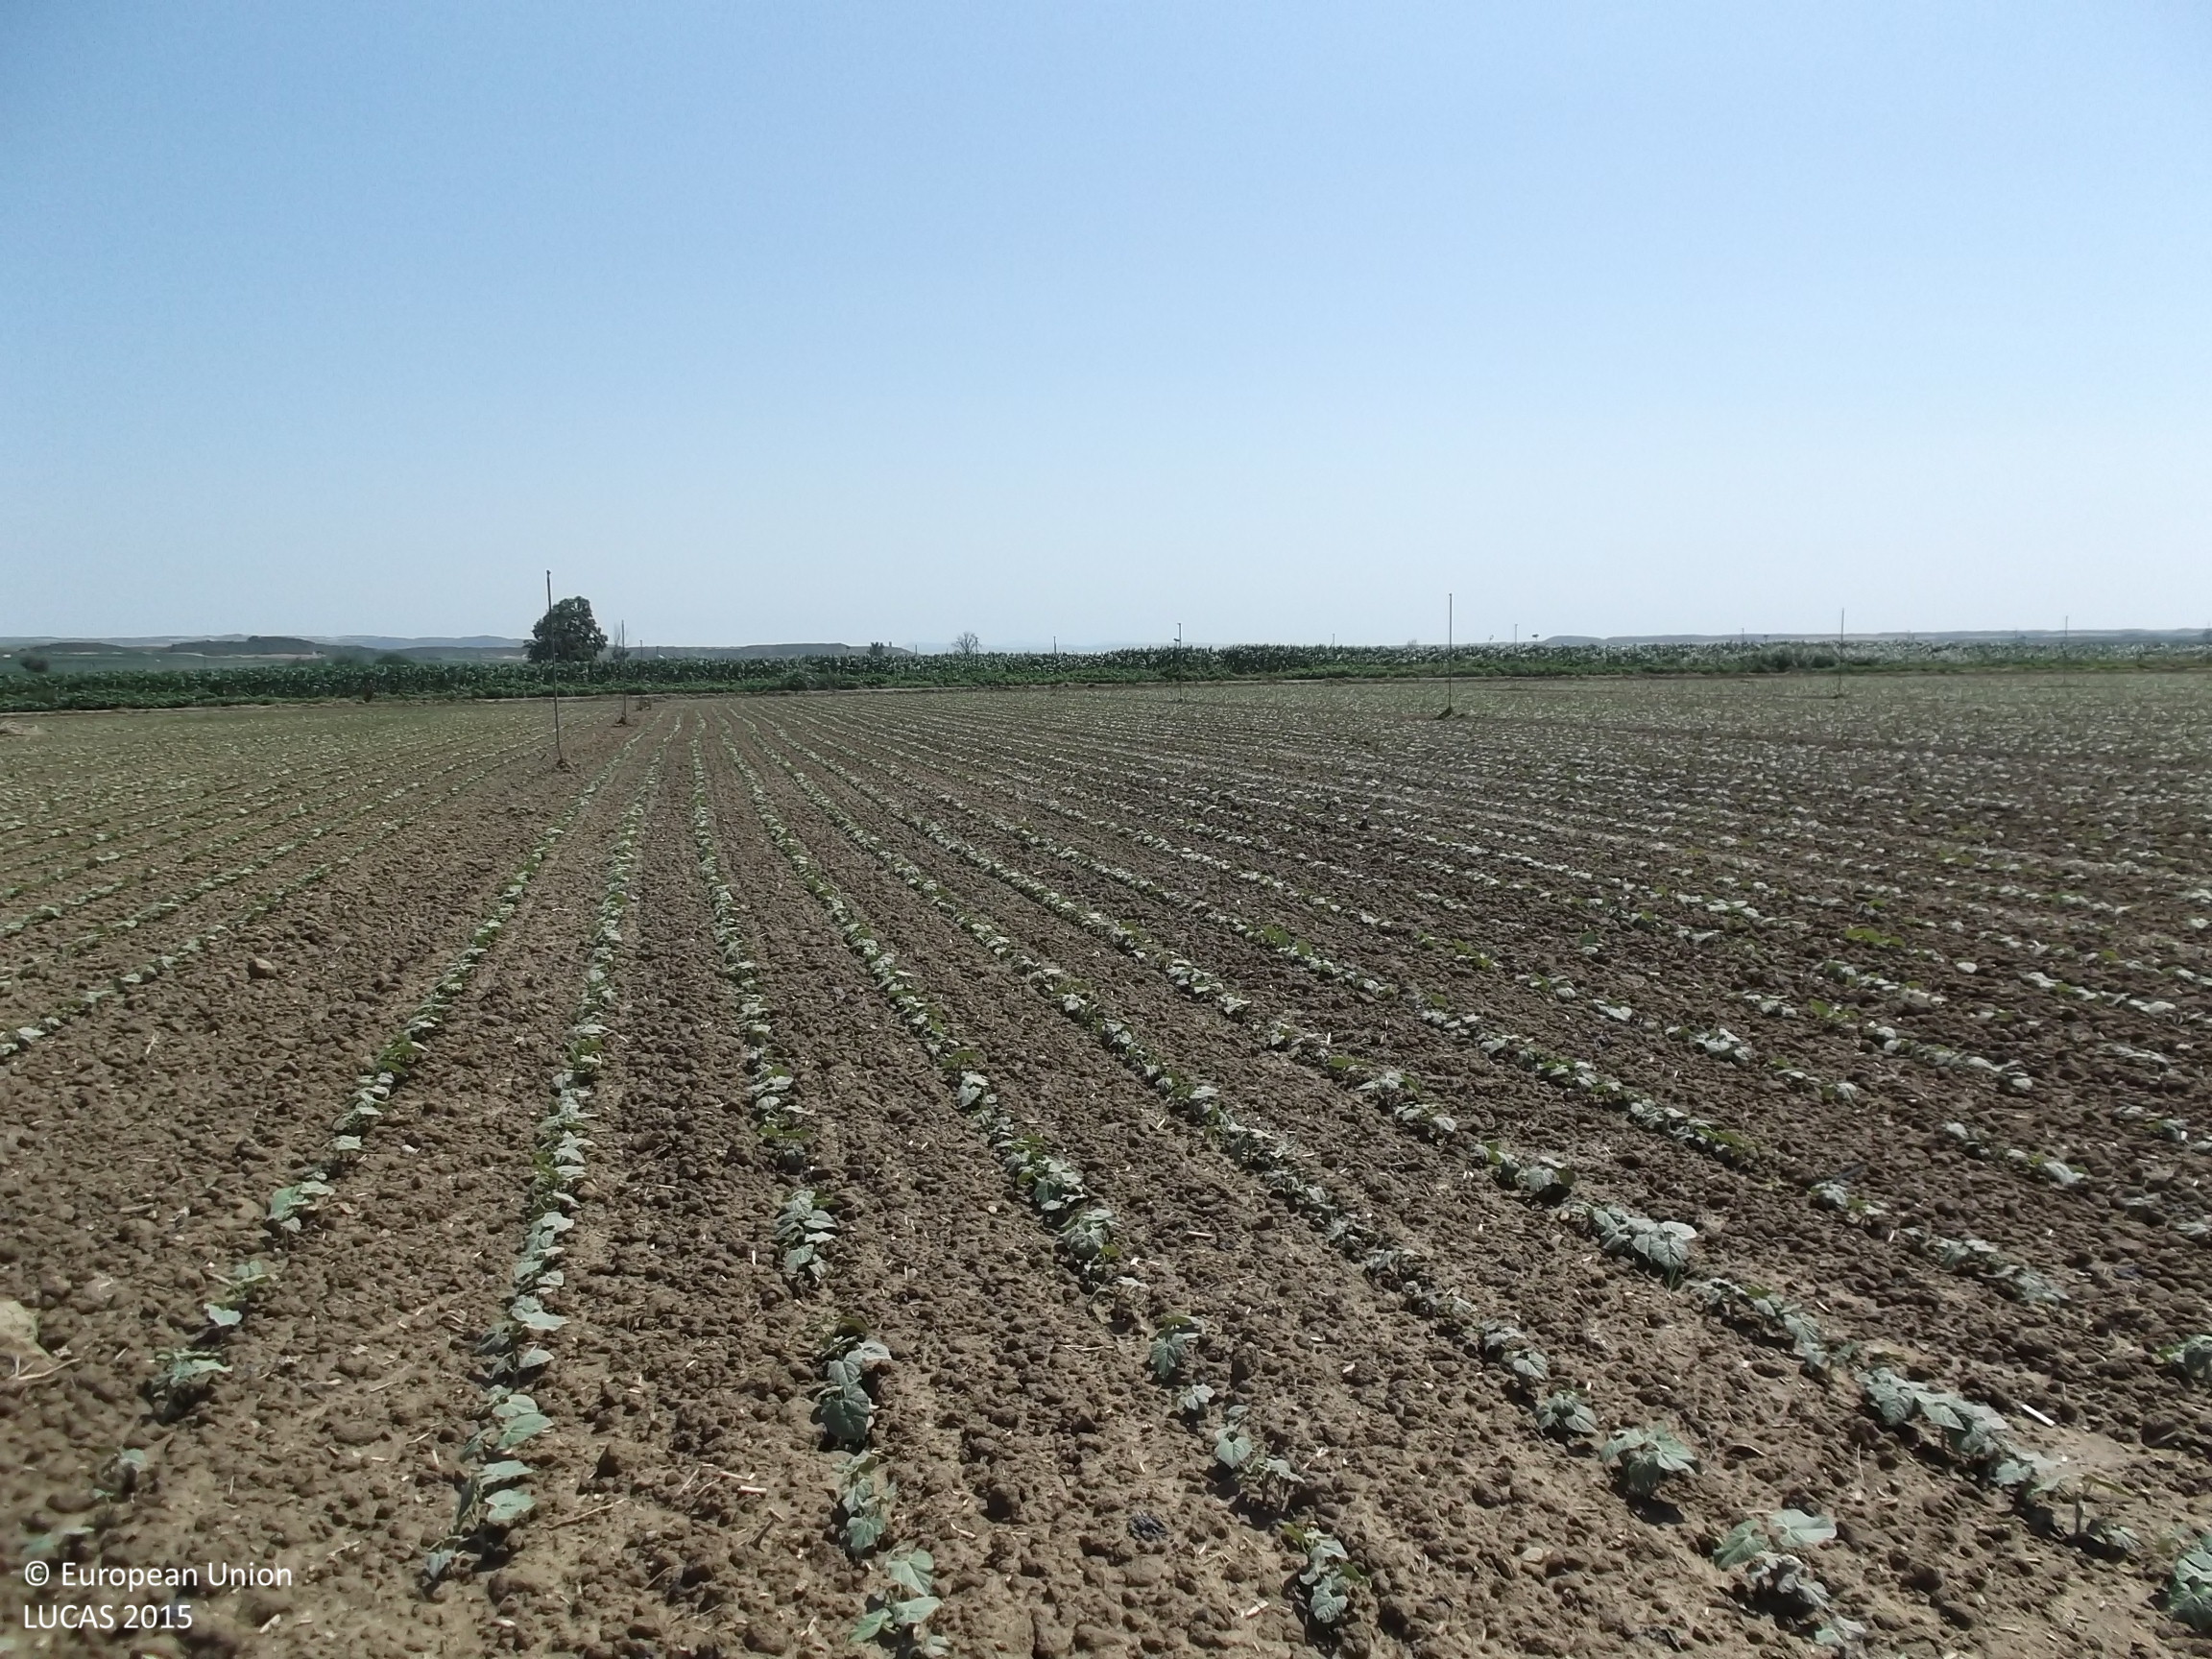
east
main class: Cropland
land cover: Dry pulses
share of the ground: < 10 %
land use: Agriculture (excluding fallow land and kitchen gardens)
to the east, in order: Dry pulses; Grass margins; Tracks; Grass margins; Maize
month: July
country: ES
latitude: 42.3644
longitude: -1.6308
